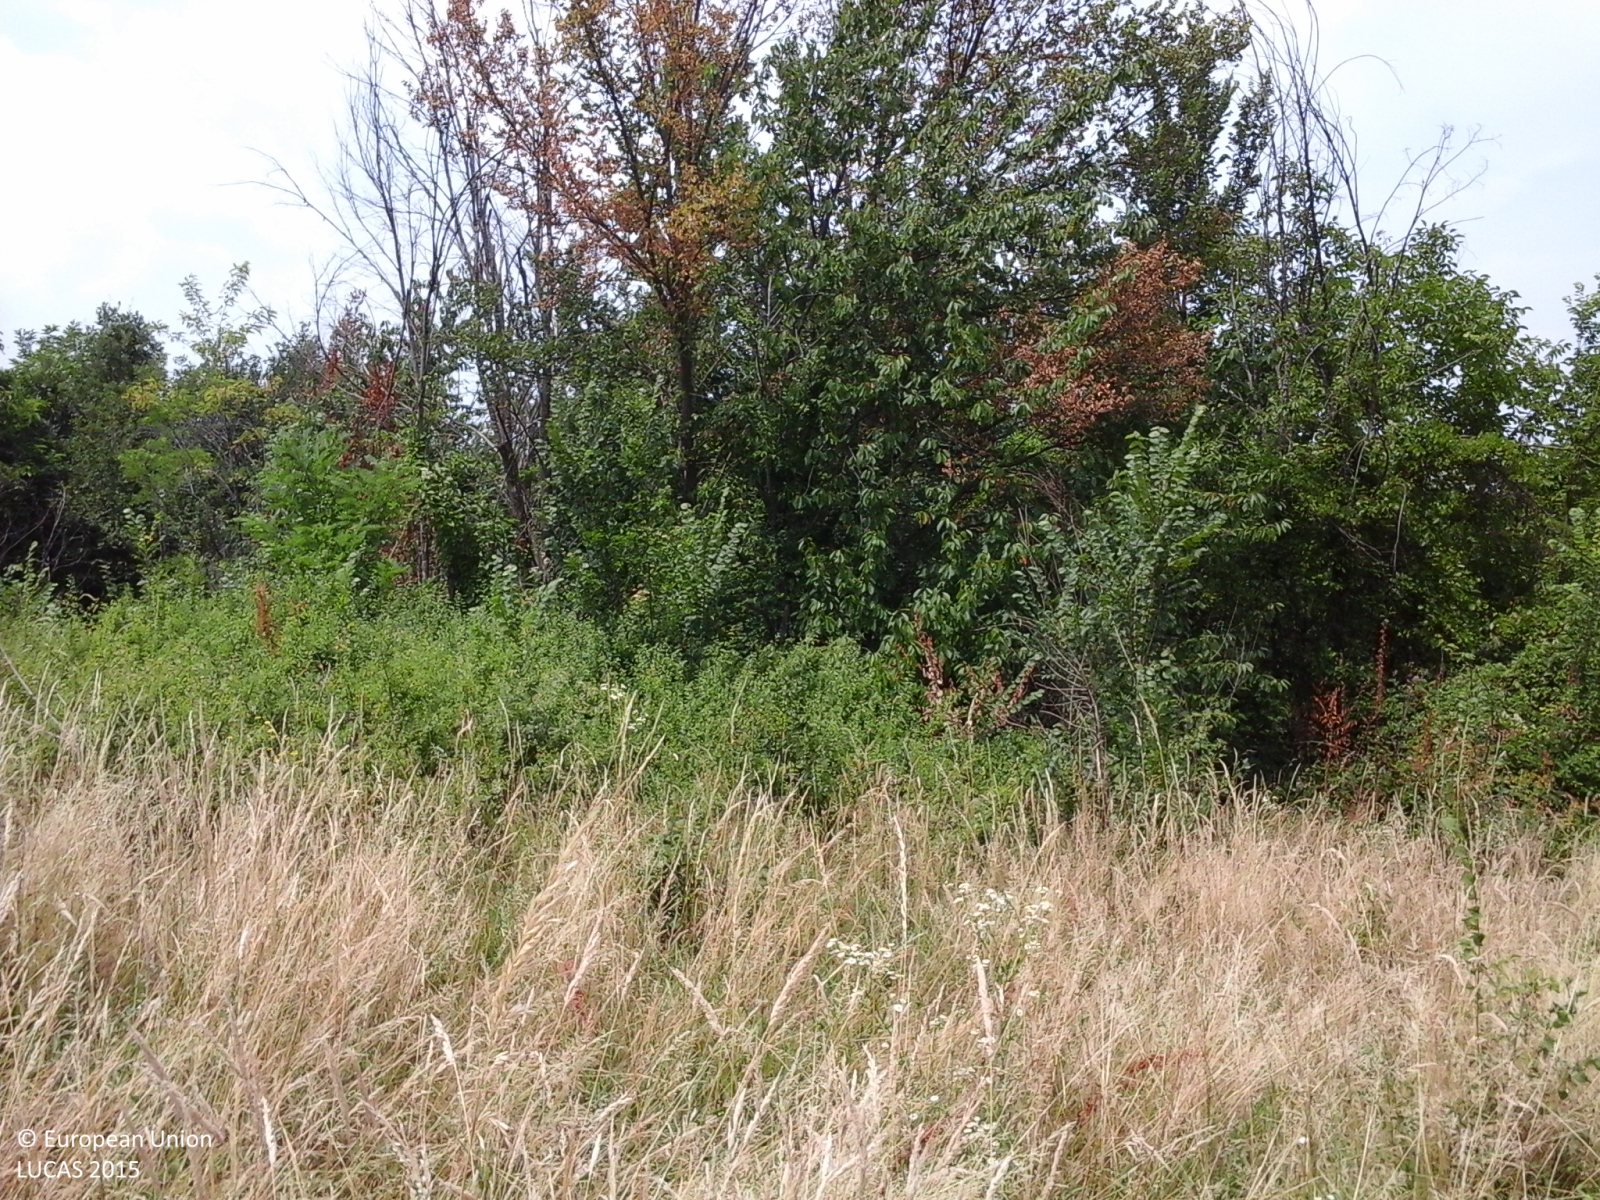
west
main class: Grassland
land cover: Grassland without tree/shrub cover
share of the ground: > 75 %
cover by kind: herbaceous plants 100 %
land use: Agriculture (excluding fallow land and kitchen gardens)
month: June
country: IT
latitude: 44.8730
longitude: 9.6589
